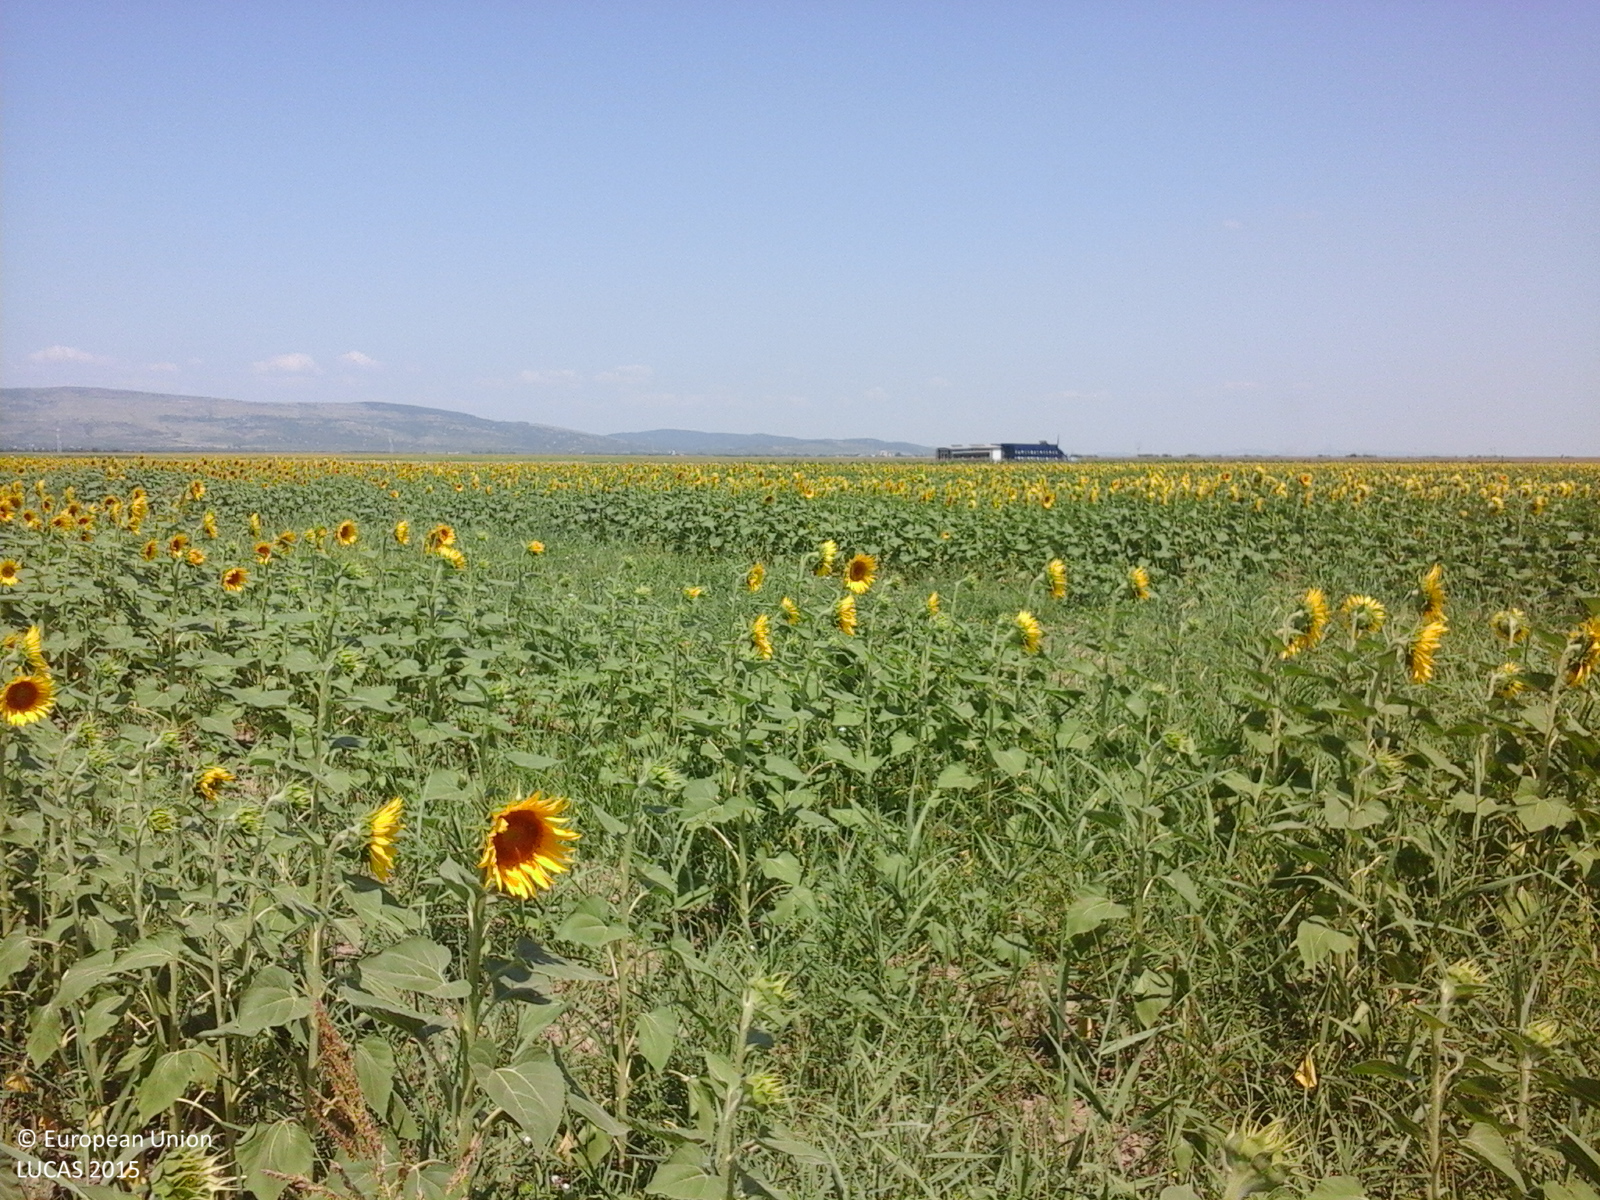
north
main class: Cropland
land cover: Sunflower
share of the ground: > 75 %
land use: Agriculture (excluding fallow land and kitchen gardens)
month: July
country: RO
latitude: 45.0361
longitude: 26.6394
